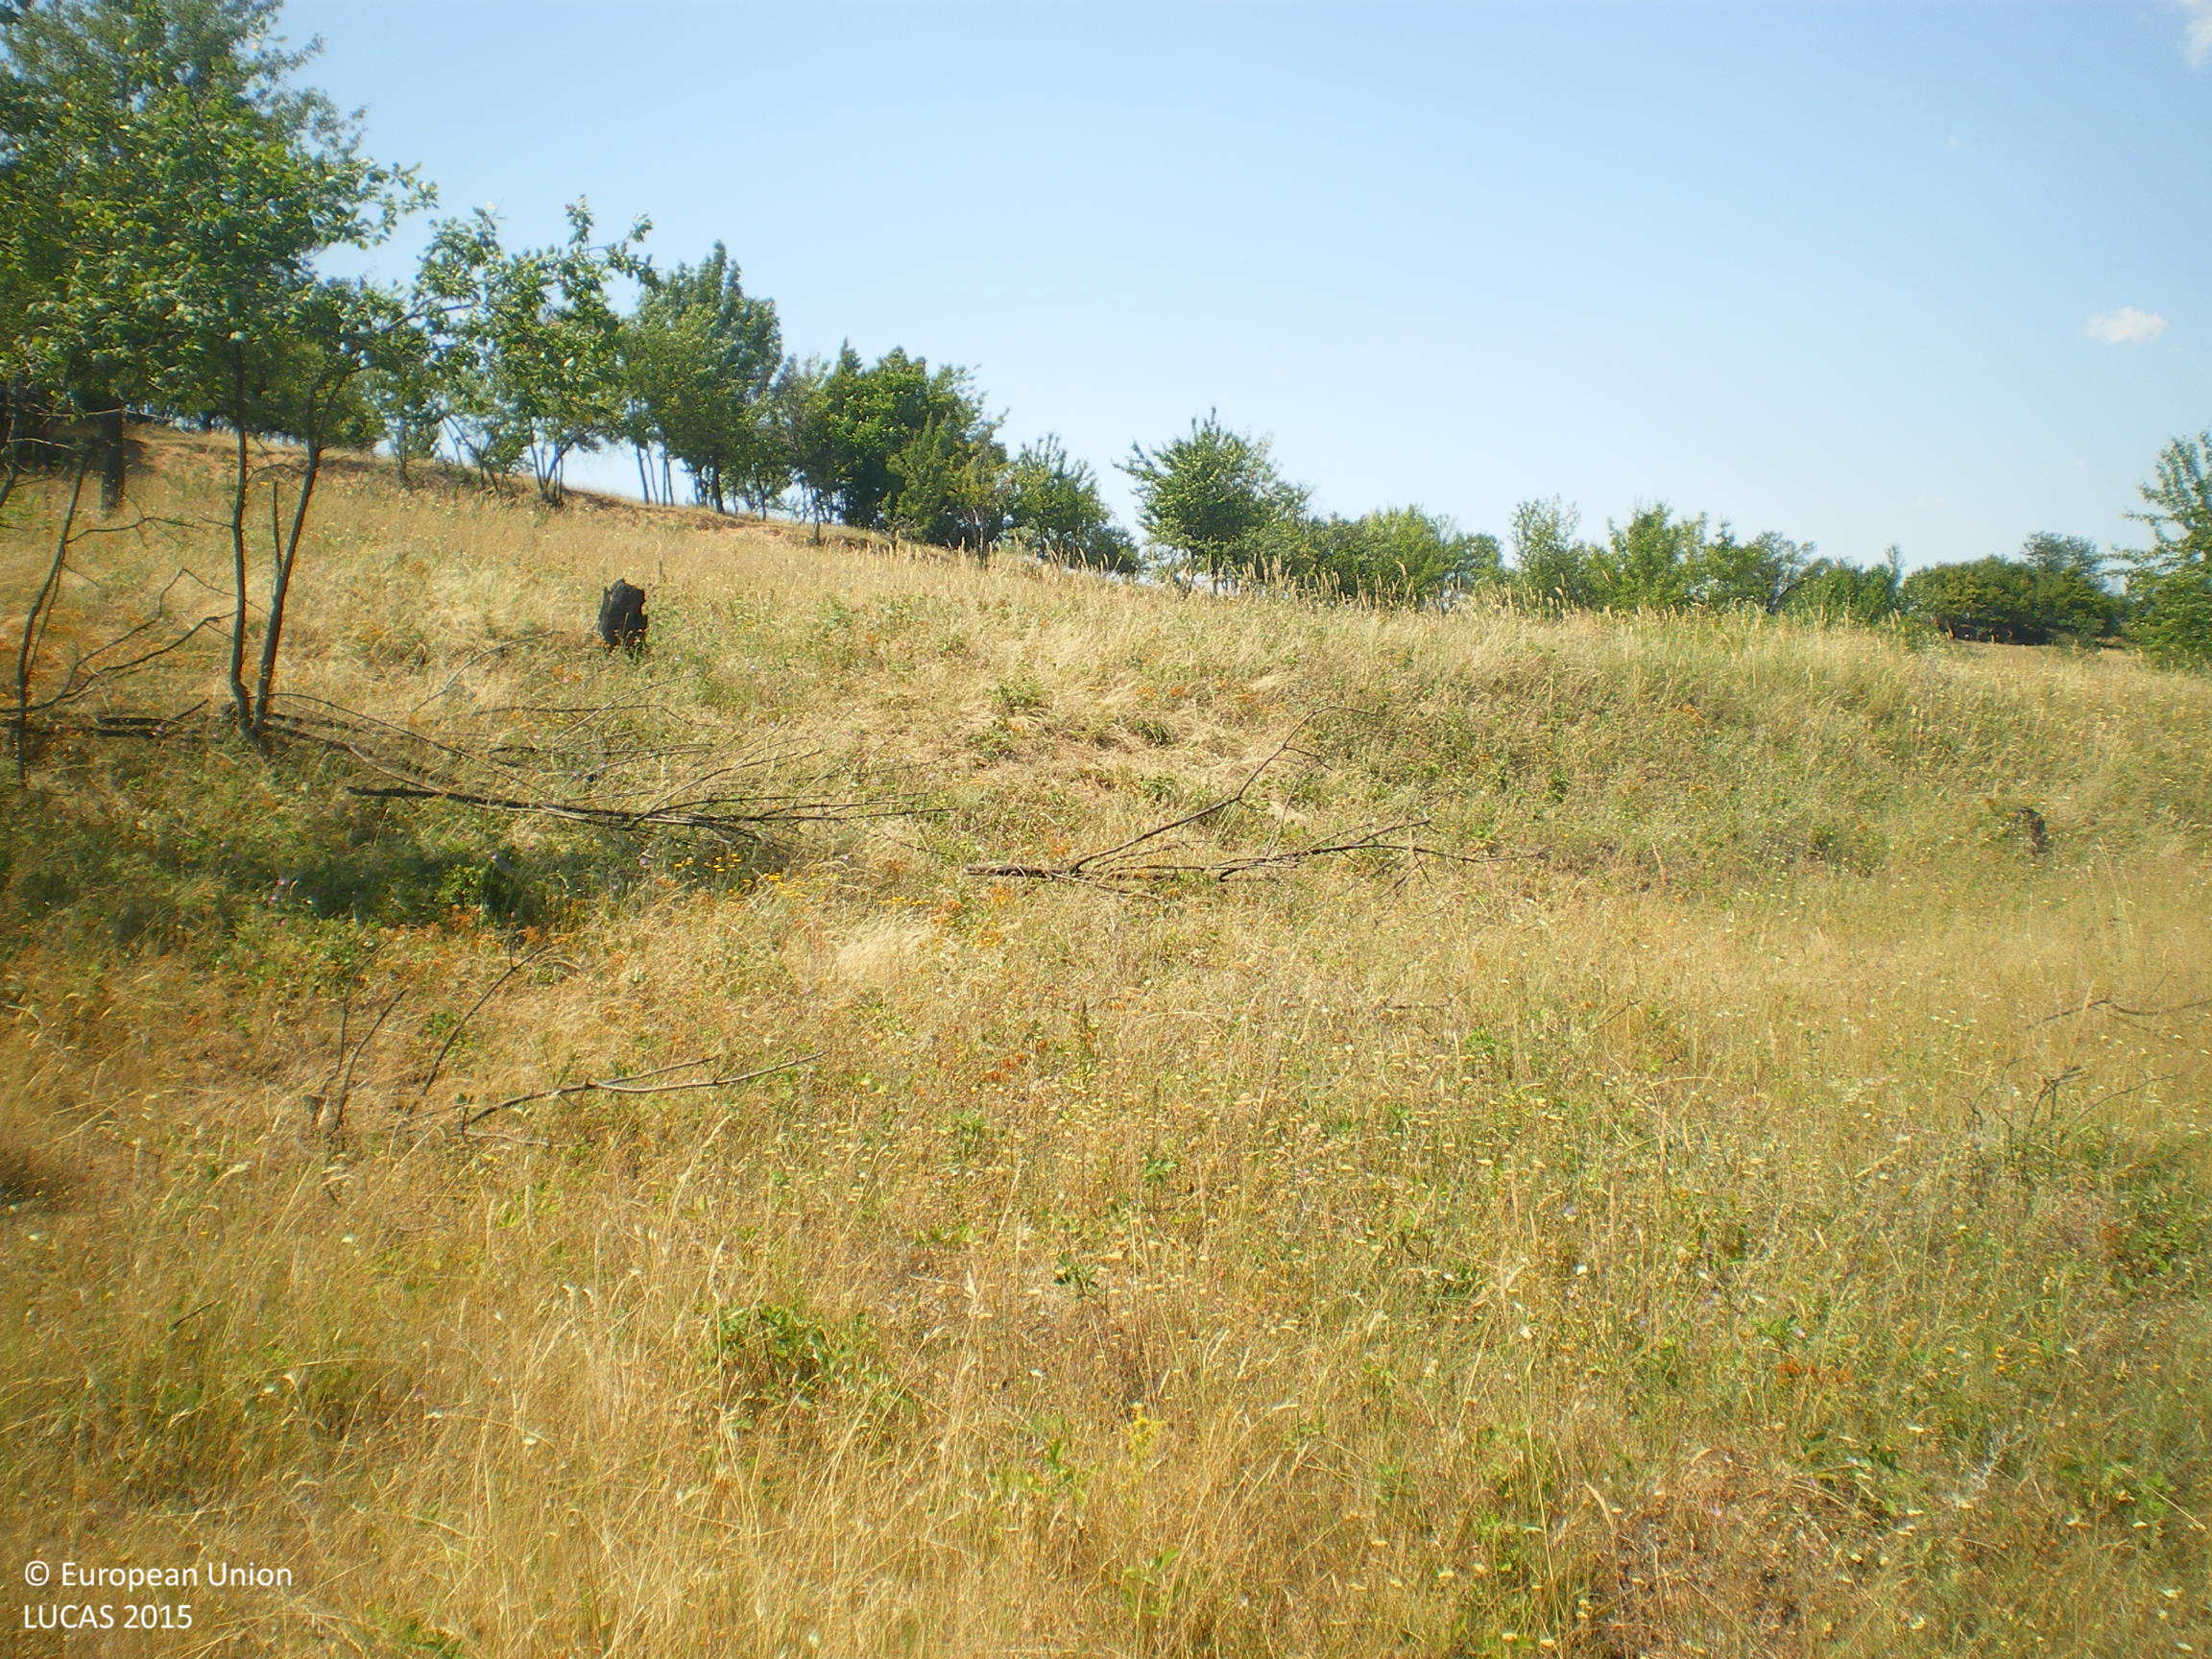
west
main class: Grassland
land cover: Grassland without tree/shrub cover
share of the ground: > 75 %
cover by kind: herbaceous plants 100 %
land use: Agriculture (excluding fallow land and kitchen gardens)
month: July
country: BG
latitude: 42.5802
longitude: 25.0858
